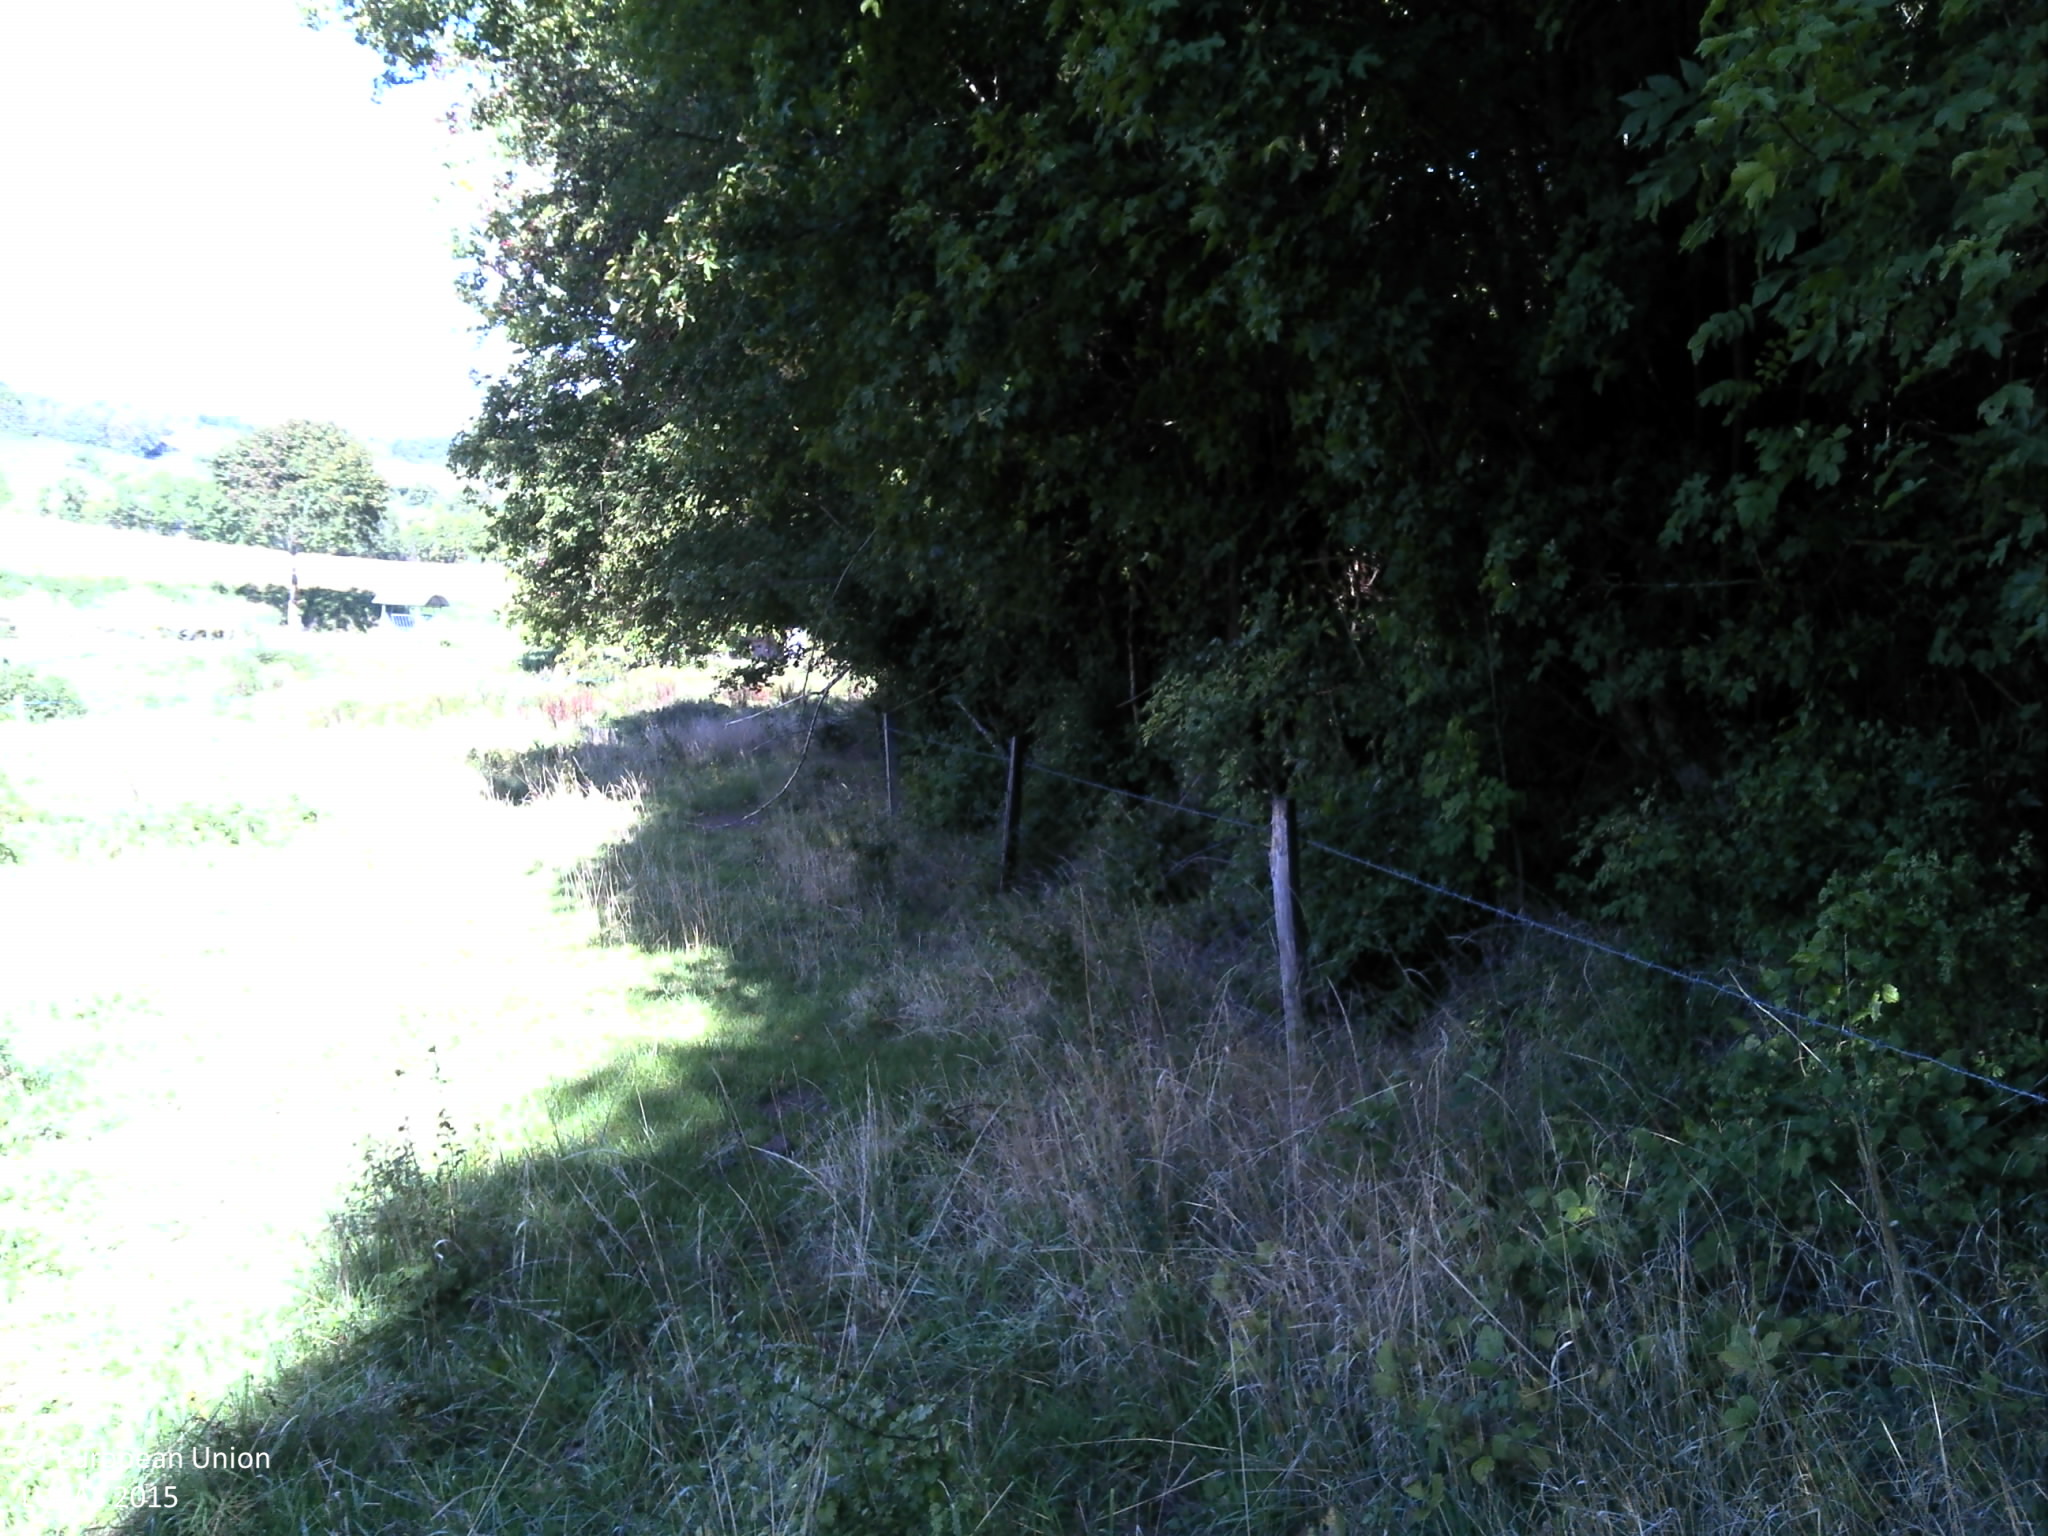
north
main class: Grassland
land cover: Grassland without tree/shrub cover
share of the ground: > 75 %
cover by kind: herbaceous plants 95 %, shrubs 5 %
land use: Agriculture (excluding fallow land and kitchen gardens)
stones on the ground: < 10 %
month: September
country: FR
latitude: 45.5675
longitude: 3.0942
